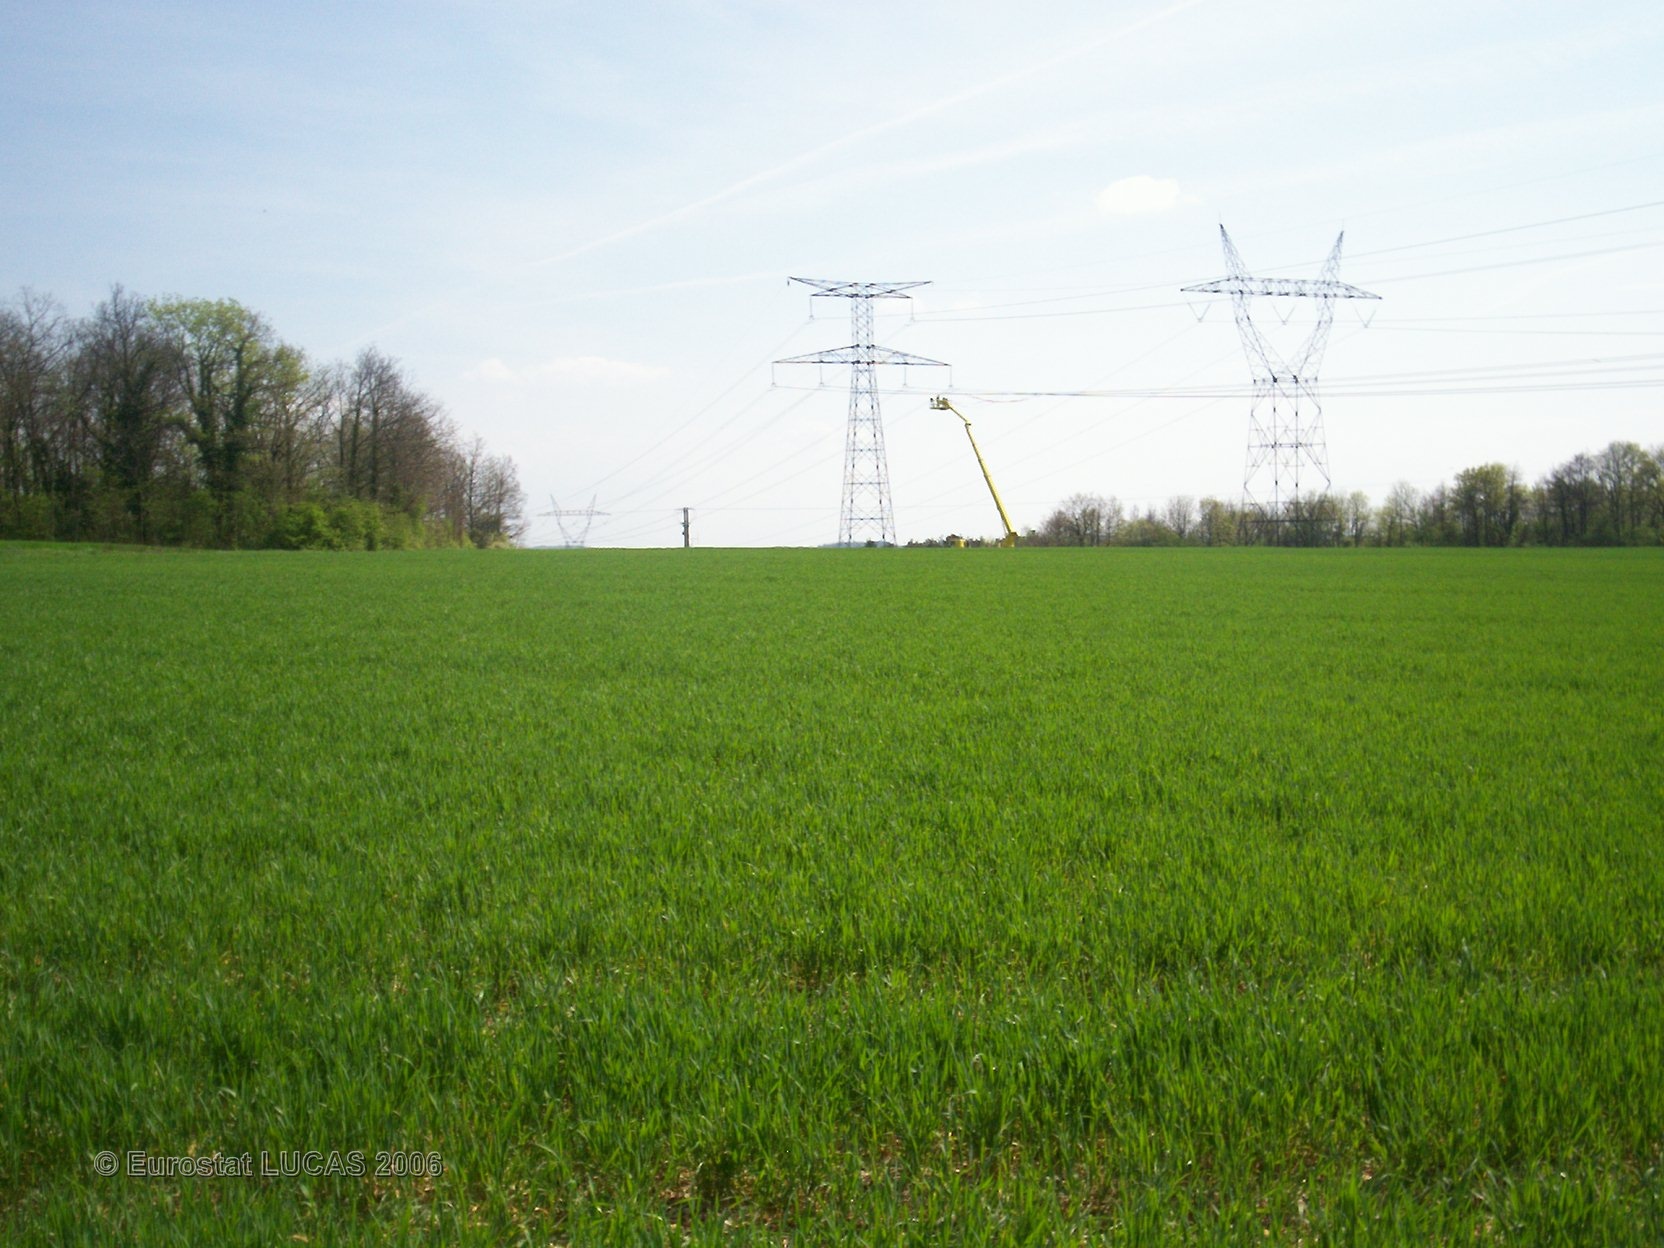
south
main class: Cropland
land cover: Common wheat
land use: Agriculture (excluding fallow land and kitchen gardens)
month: May
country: FR
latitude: 47.5317
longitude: 4.5930
